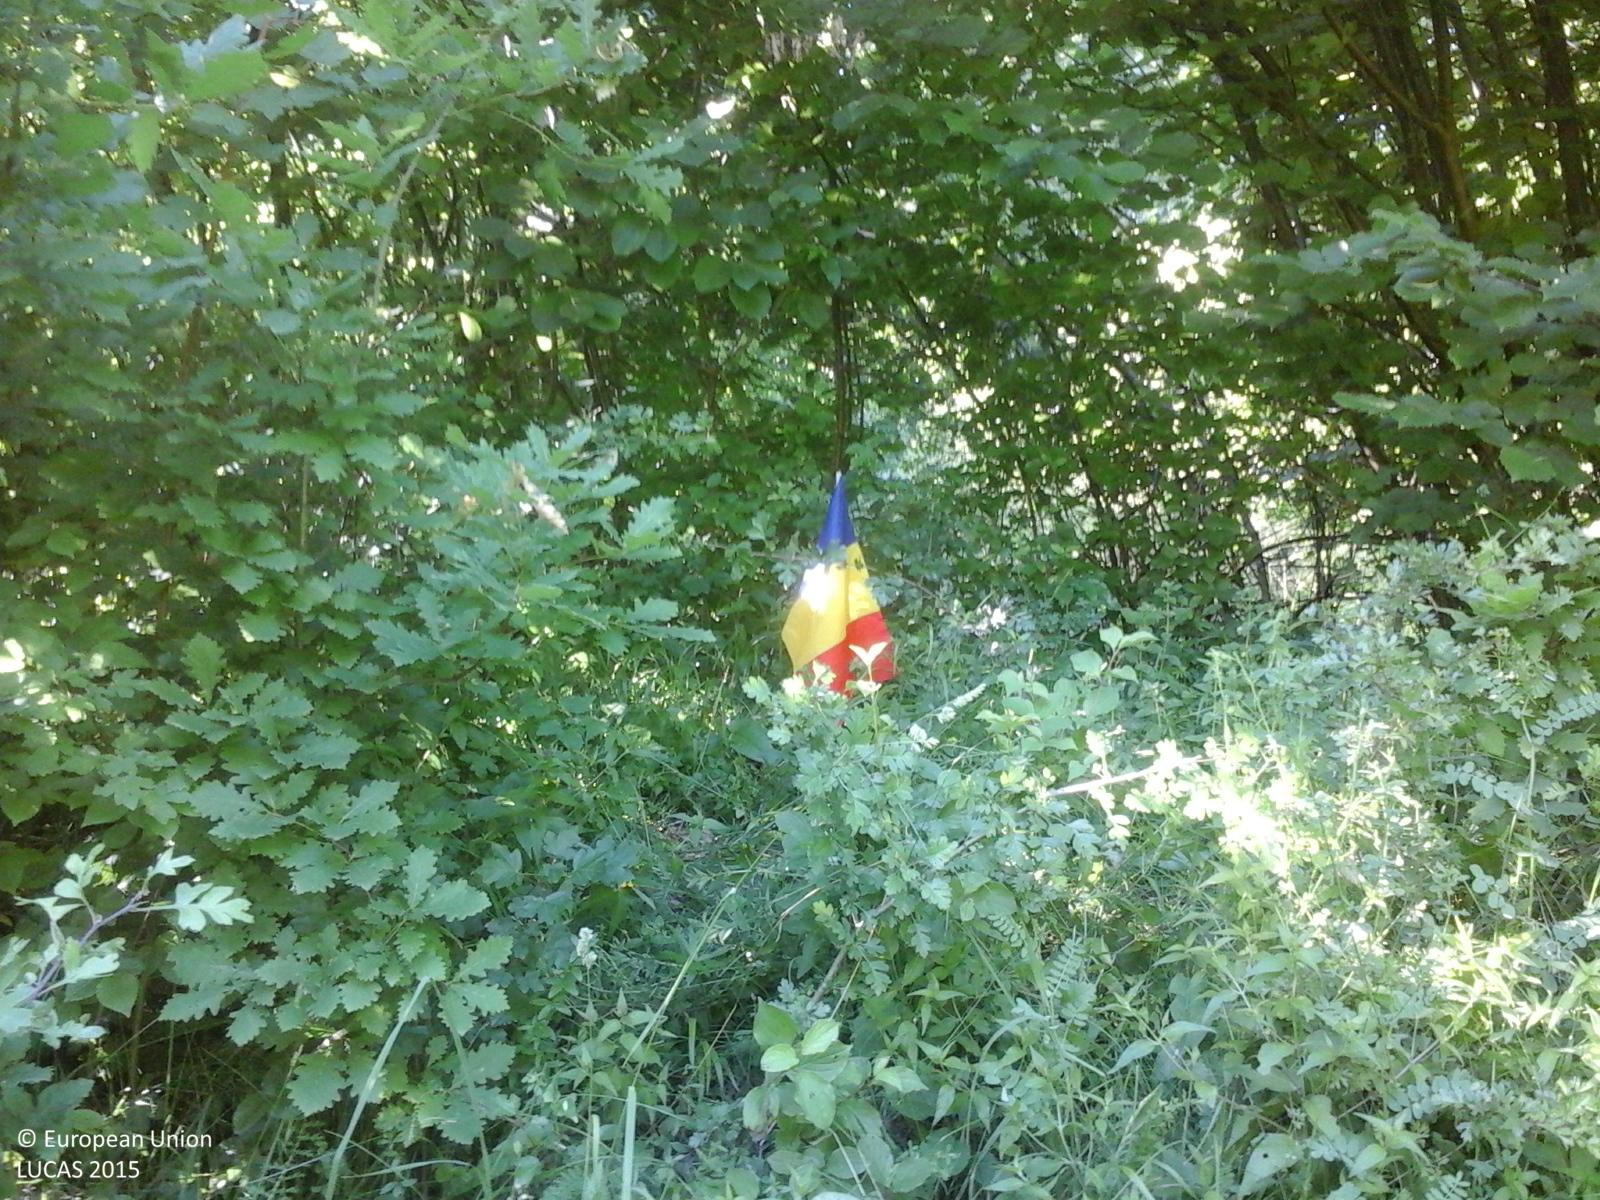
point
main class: Woodland
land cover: Broadleaved woodland
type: non-riverine alder, birch or aspen forest
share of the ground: > 75 %
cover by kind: broadleaved forest trees 100 %
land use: Forestry
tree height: > 5 m
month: June
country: RO
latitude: 45.0884
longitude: 25.7172
